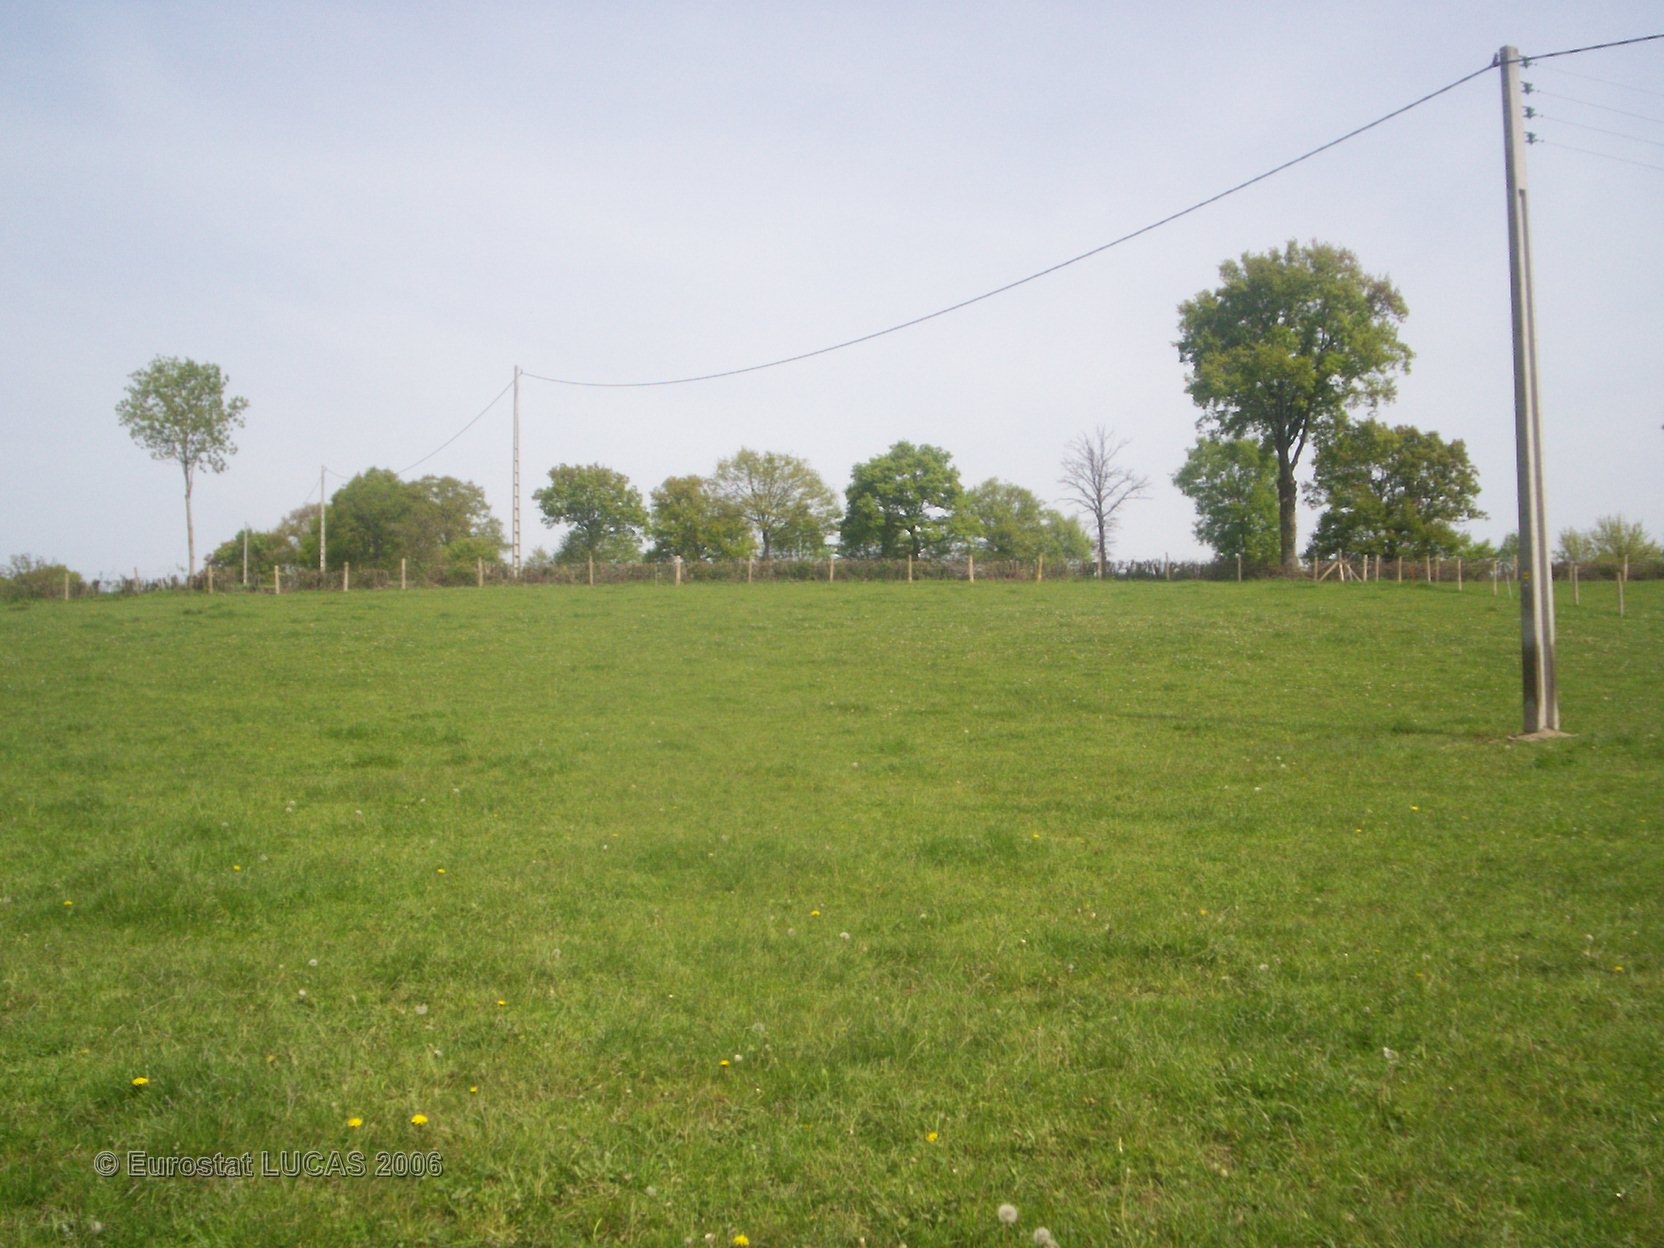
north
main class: Grassland
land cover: Grassland without tree/shrub cover
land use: Agriculture (excluding fallow land and kitchen gardens)
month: May
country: FR
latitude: 46.5439
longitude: 3.0988
